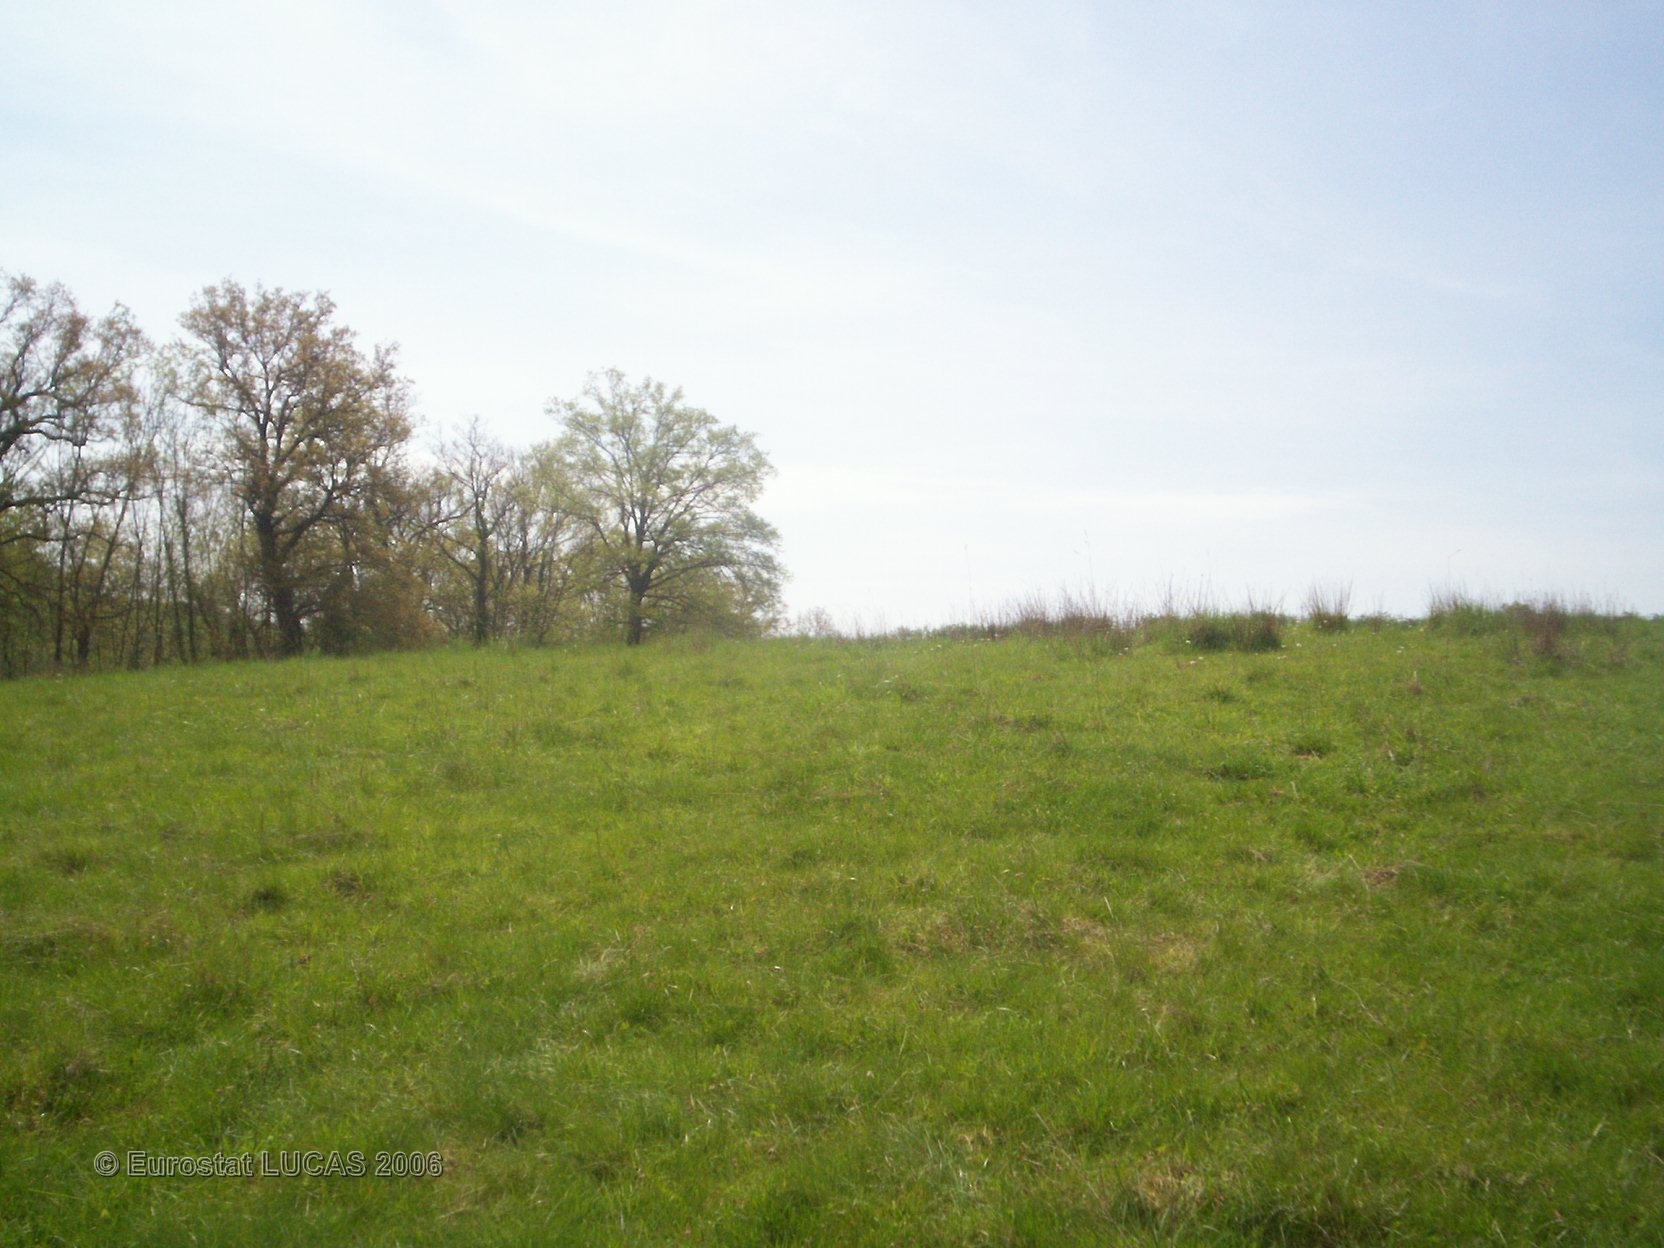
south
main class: Grassland
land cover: Grassland without tree/shrub cover
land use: Agriculture (excluding fallow land and kitchen gardens)
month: May
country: FR
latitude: 46.5064
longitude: 3.0775
